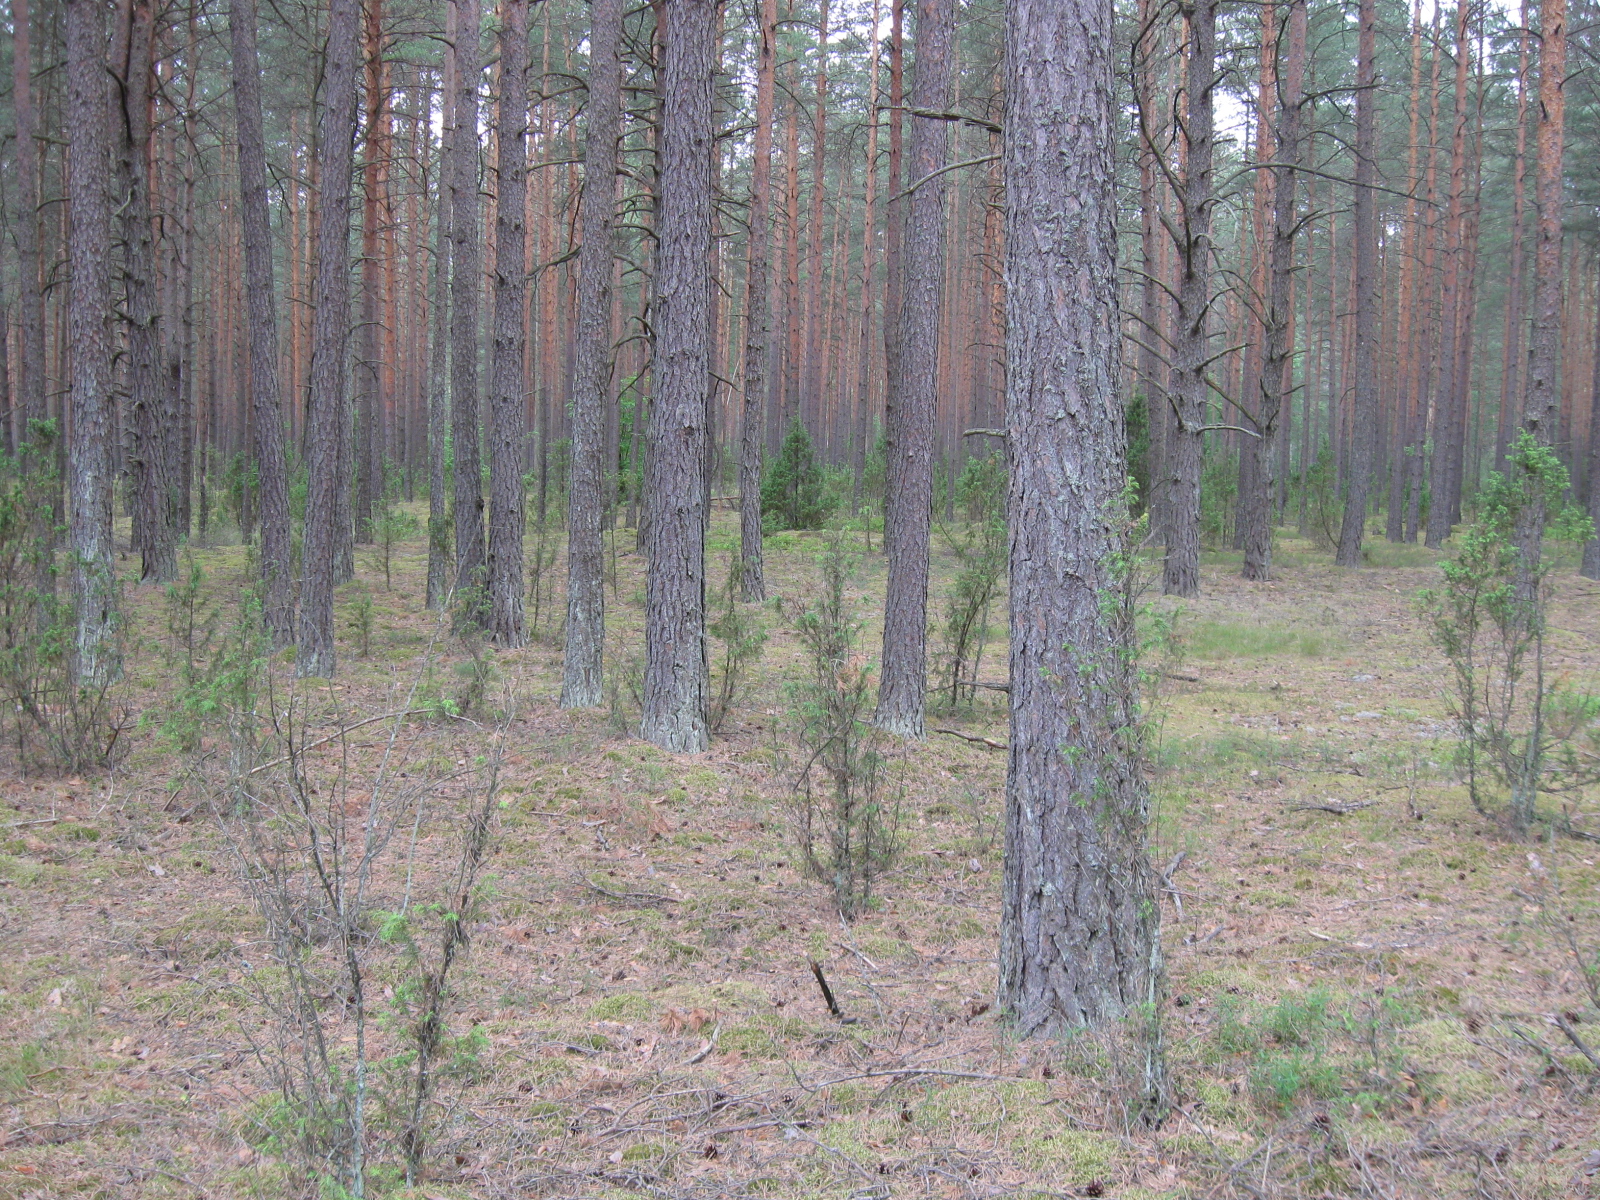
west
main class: Woodland
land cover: Pine dominated coniferous woodland
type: hemiboreal forest and nemoral coniferous forest and mixed broadleaved-coniferous forest
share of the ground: > 75 %
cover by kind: coniferous forest trees 95 %, lichens and mosses 5 %
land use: Forestry
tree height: > 5 m
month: July
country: LT
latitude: 54.1775
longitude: 24.2704
